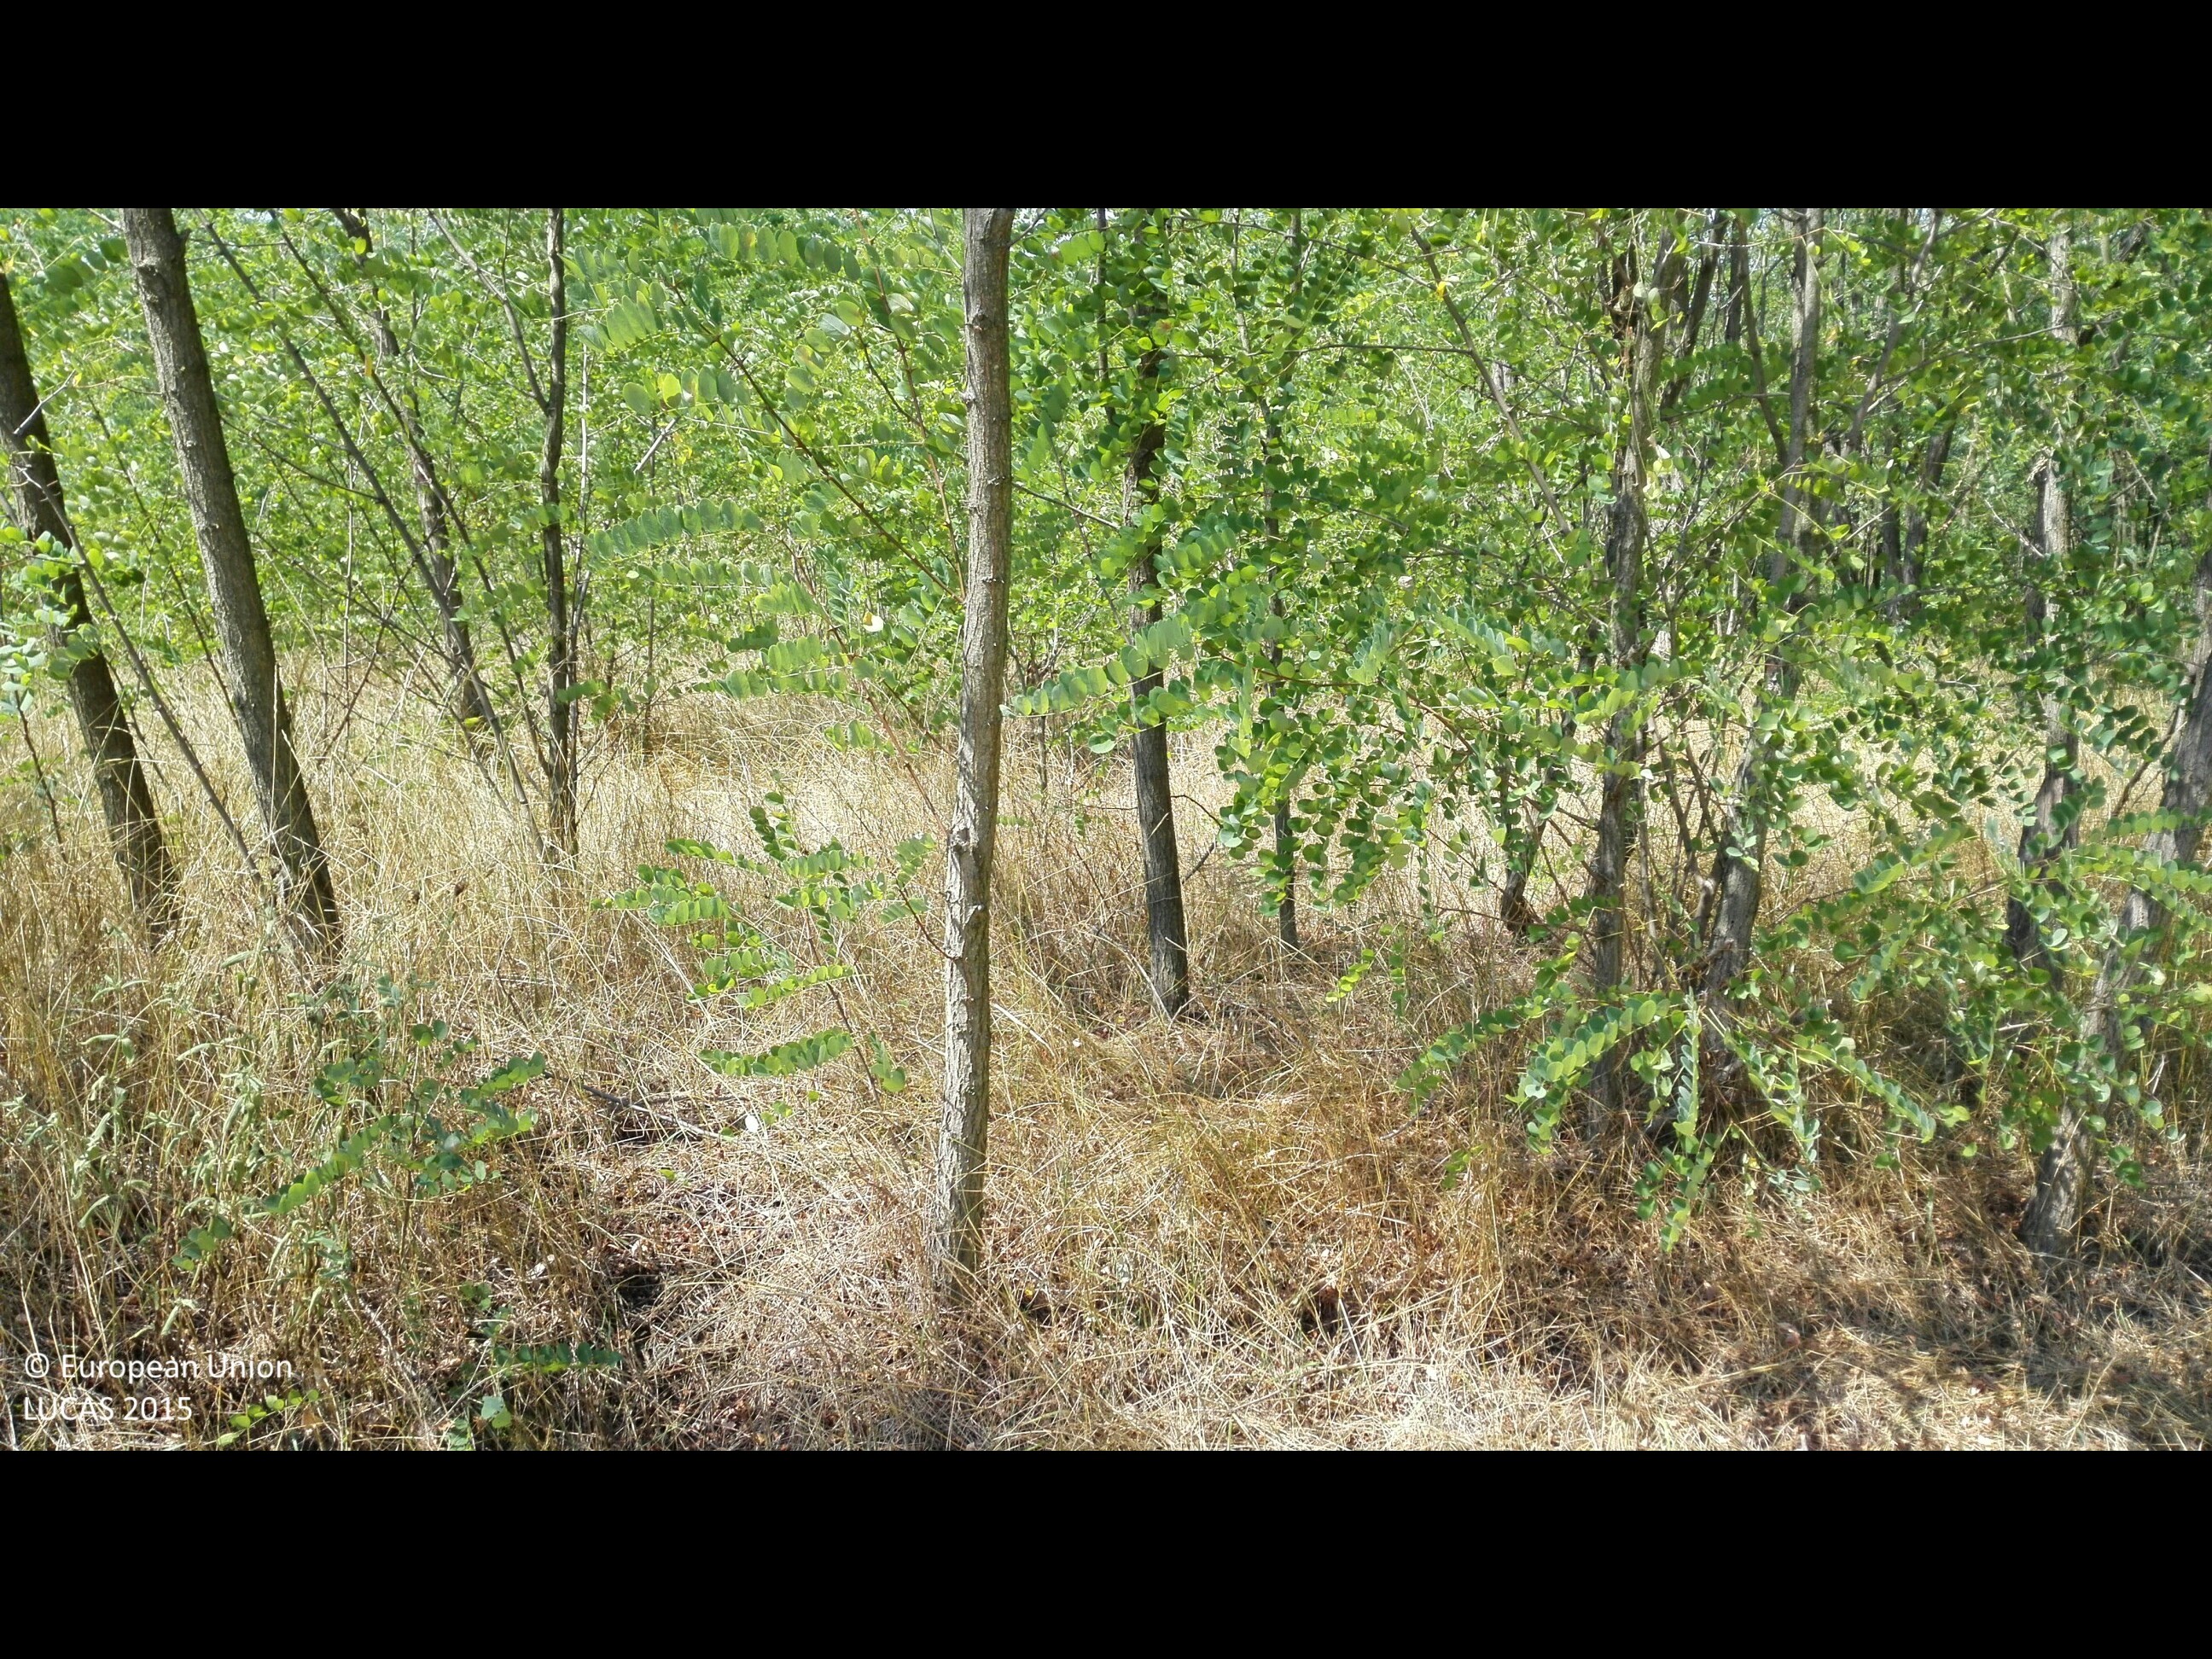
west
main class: Woodland
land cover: Broadleaved woodland
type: exotic forest
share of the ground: > 75 %
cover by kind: broadleaved forest trees 85 %, coniferous forest trees 10 %, herbaceous plants 5 %
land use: Forestry
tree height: > 5 m
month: August
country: HU
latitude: 47.5950
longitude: 22.0601
